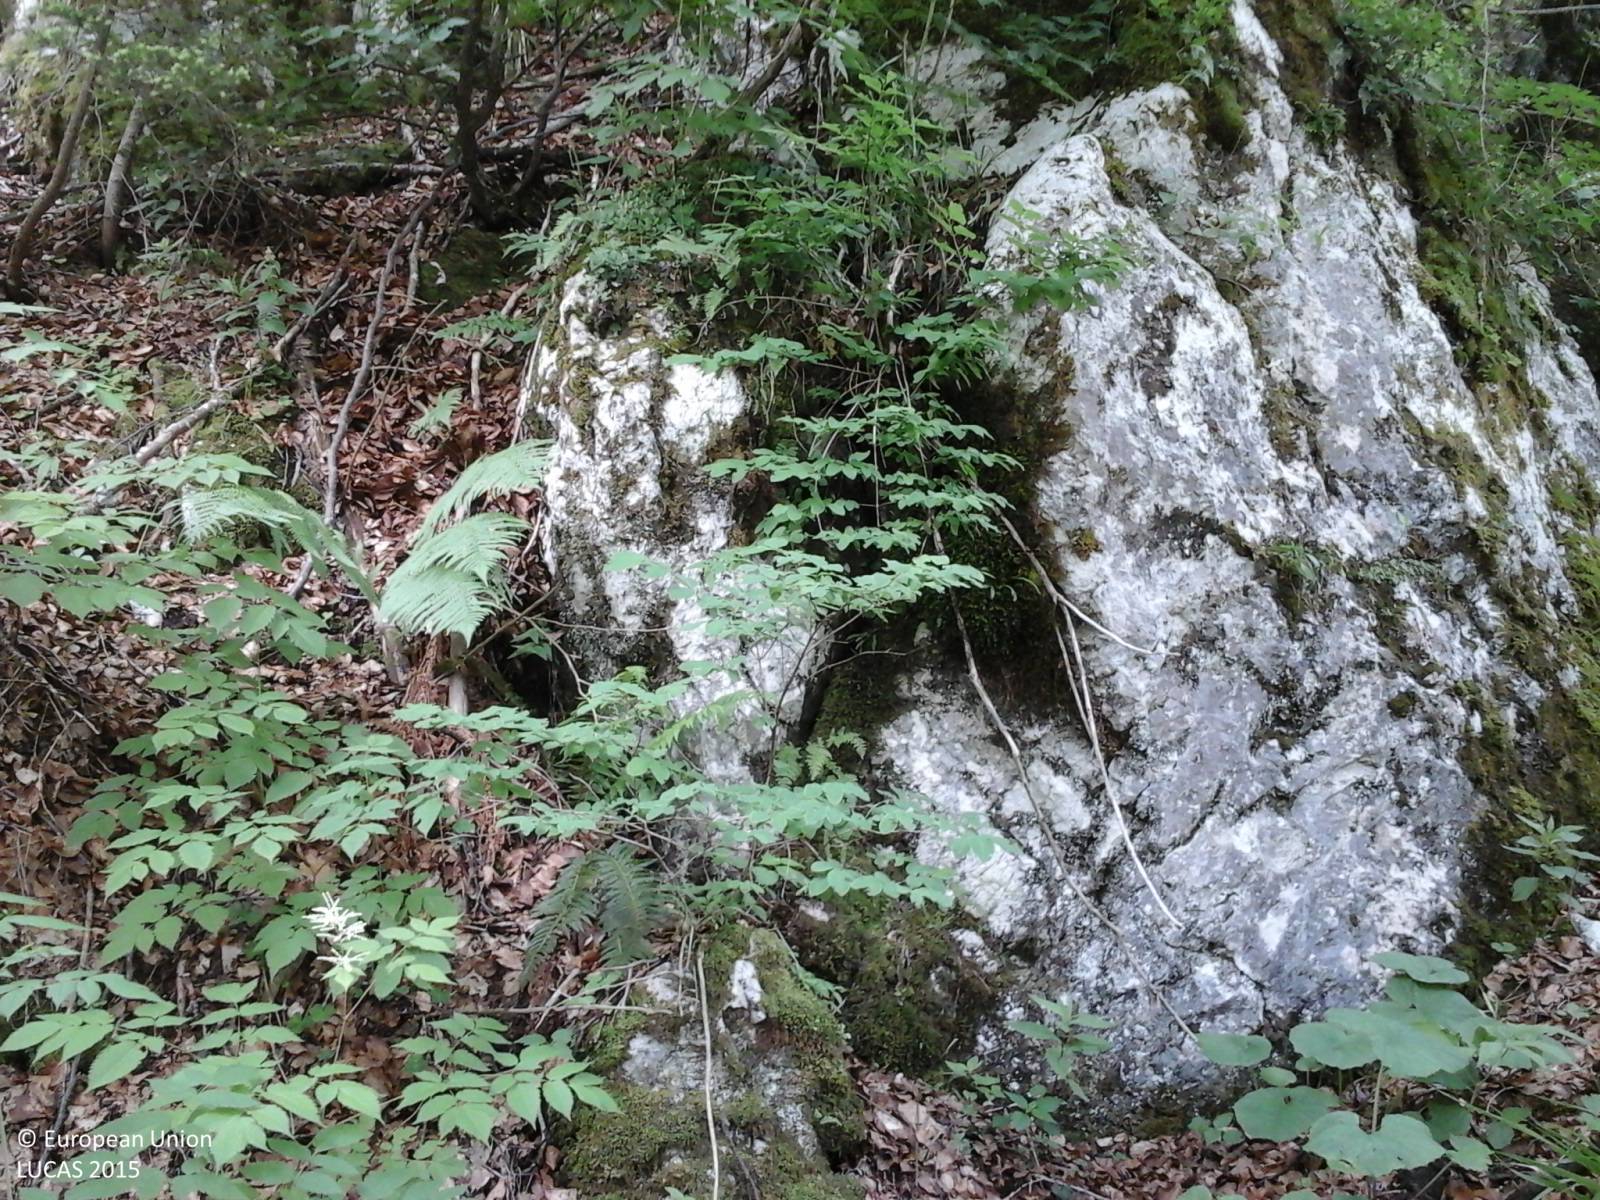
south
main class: Woodland
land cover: Other mixed woodland
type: alpine coniferous forest
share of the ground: > 75 %
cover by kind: coniferous forest trees 50 %, broadleaved forest trees 50 %
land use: Semi-natural and natural areas not in use
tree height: > 5 m
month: June
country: IT
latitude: 46.3851
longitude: 13.4686
